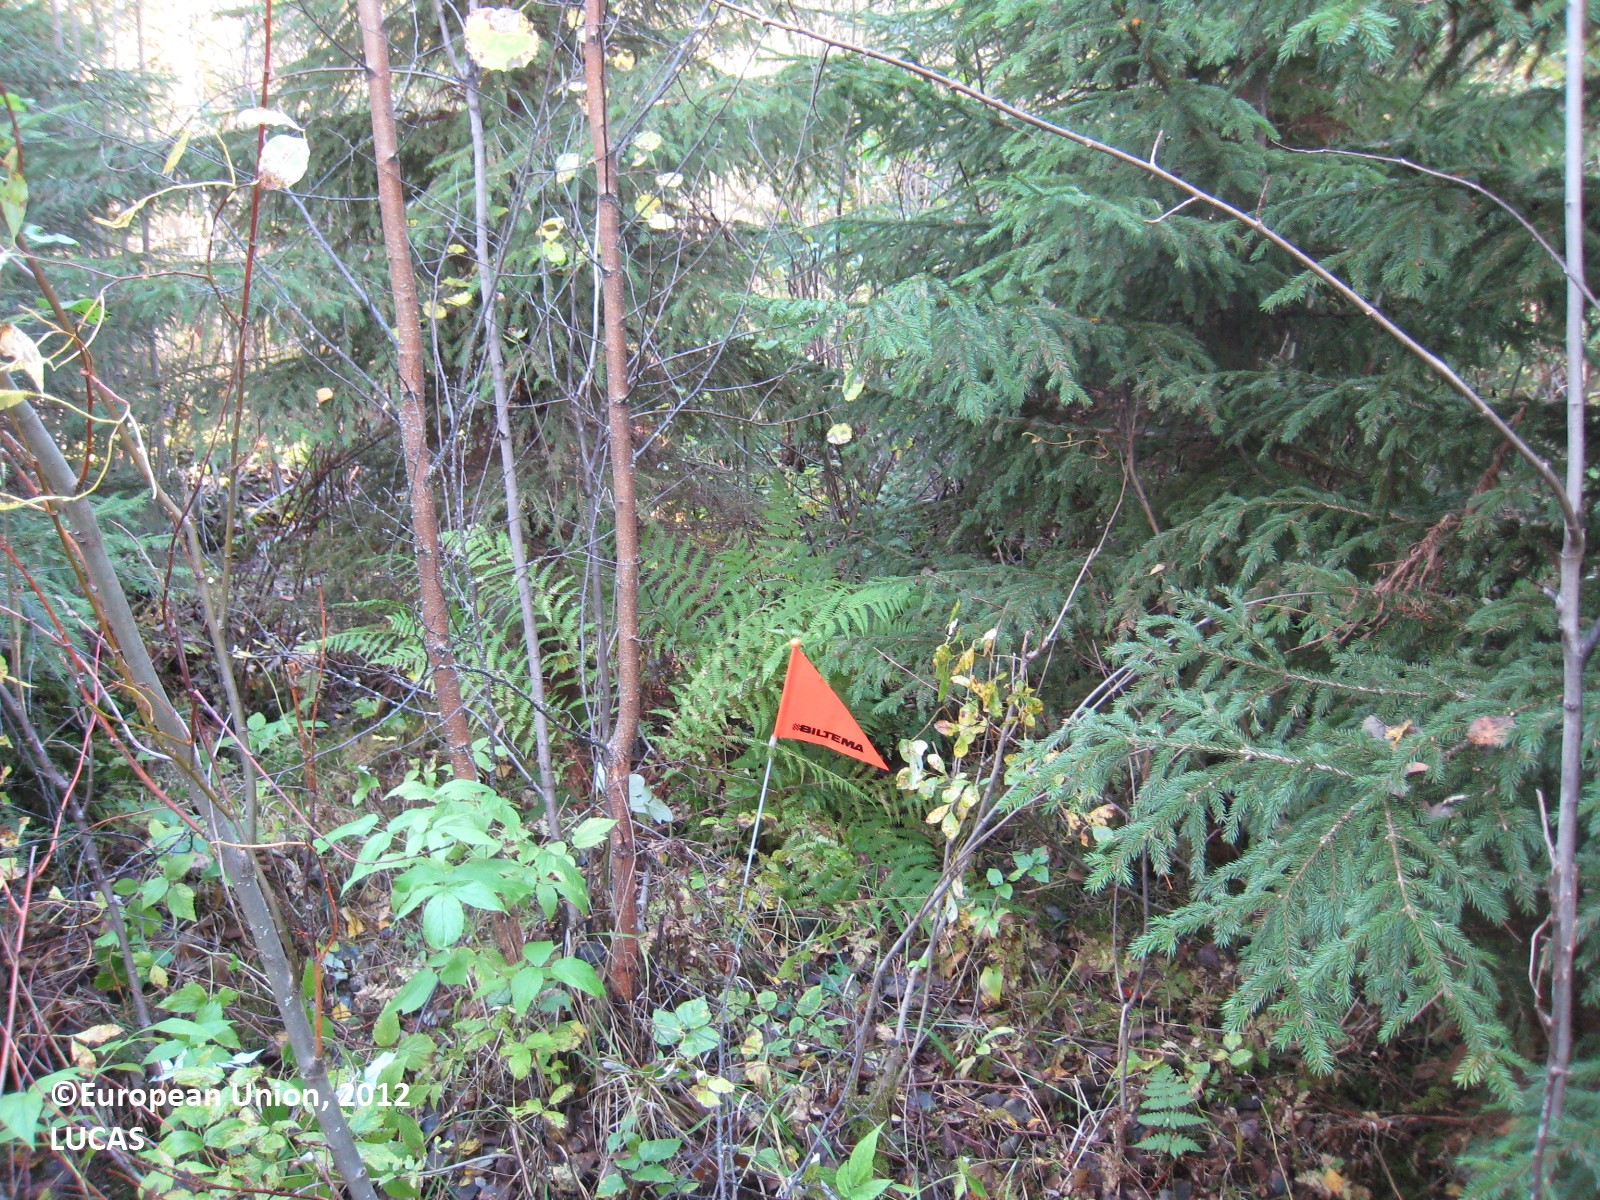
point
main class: Woodland
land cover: Spruce dominated mixed woodland
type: boreal forest
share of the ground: > 75 %
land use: Forestry
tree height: > 5 m
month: September
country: FI
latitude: 62.6409
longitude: 26.6208
